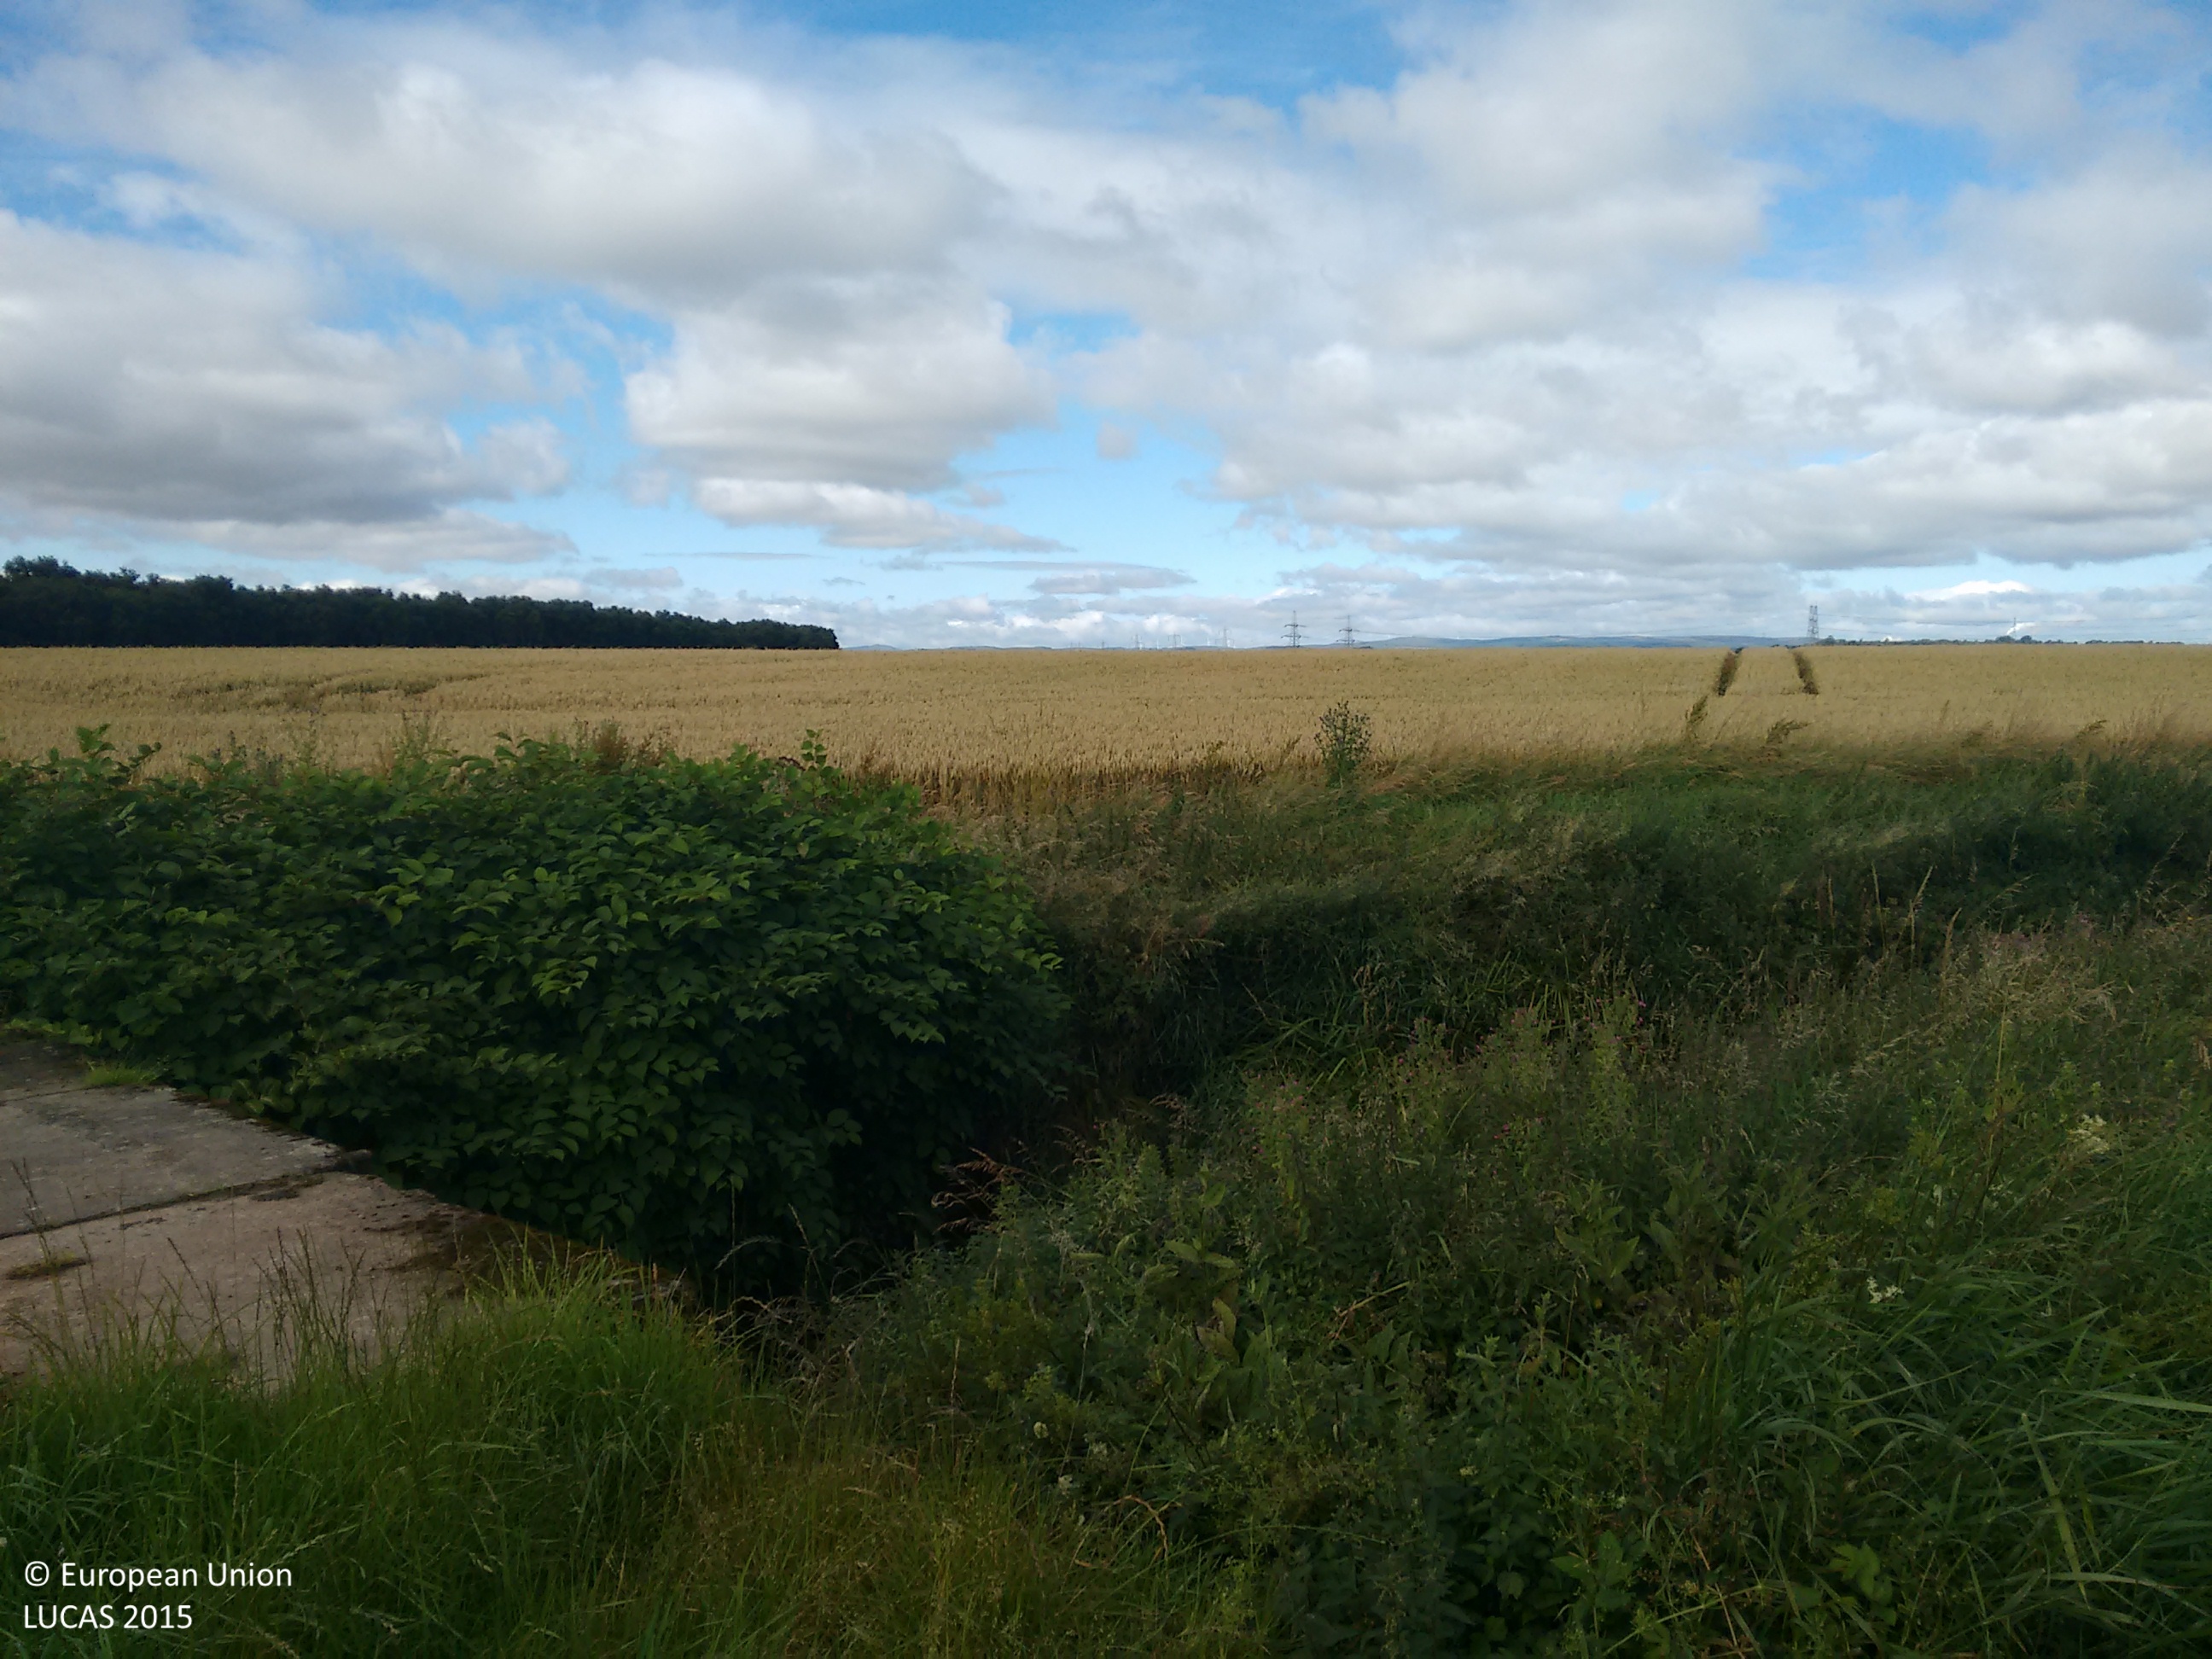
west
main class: Cropland
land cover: Barley
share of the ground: > 75 %
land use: Agriculture (excluding fallow land and kitchen gardens)
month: August
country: GB
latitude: 56.0605
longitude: -3.7816
